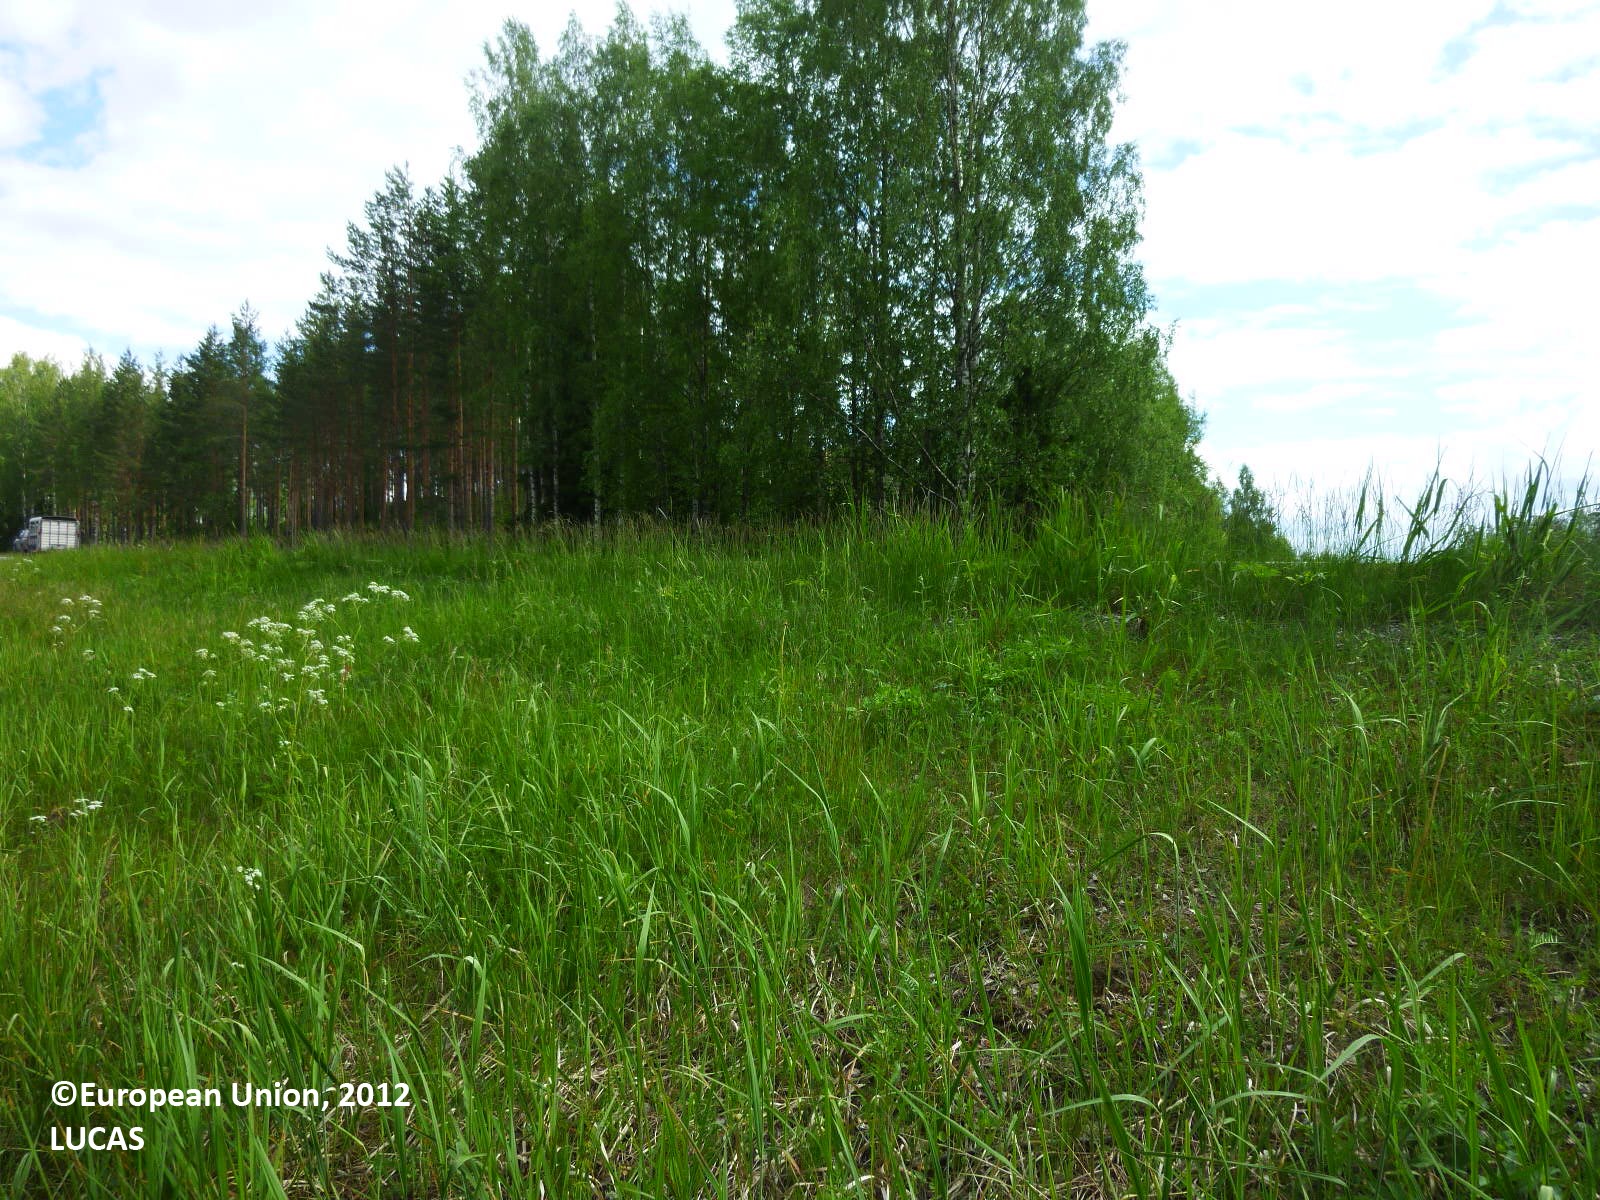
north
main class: Grassland
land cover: Grassland without tree/shrub cover
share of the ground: > 75 %
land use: Road transport
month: June
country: FI
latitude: 61.4780
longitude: 22.5868
